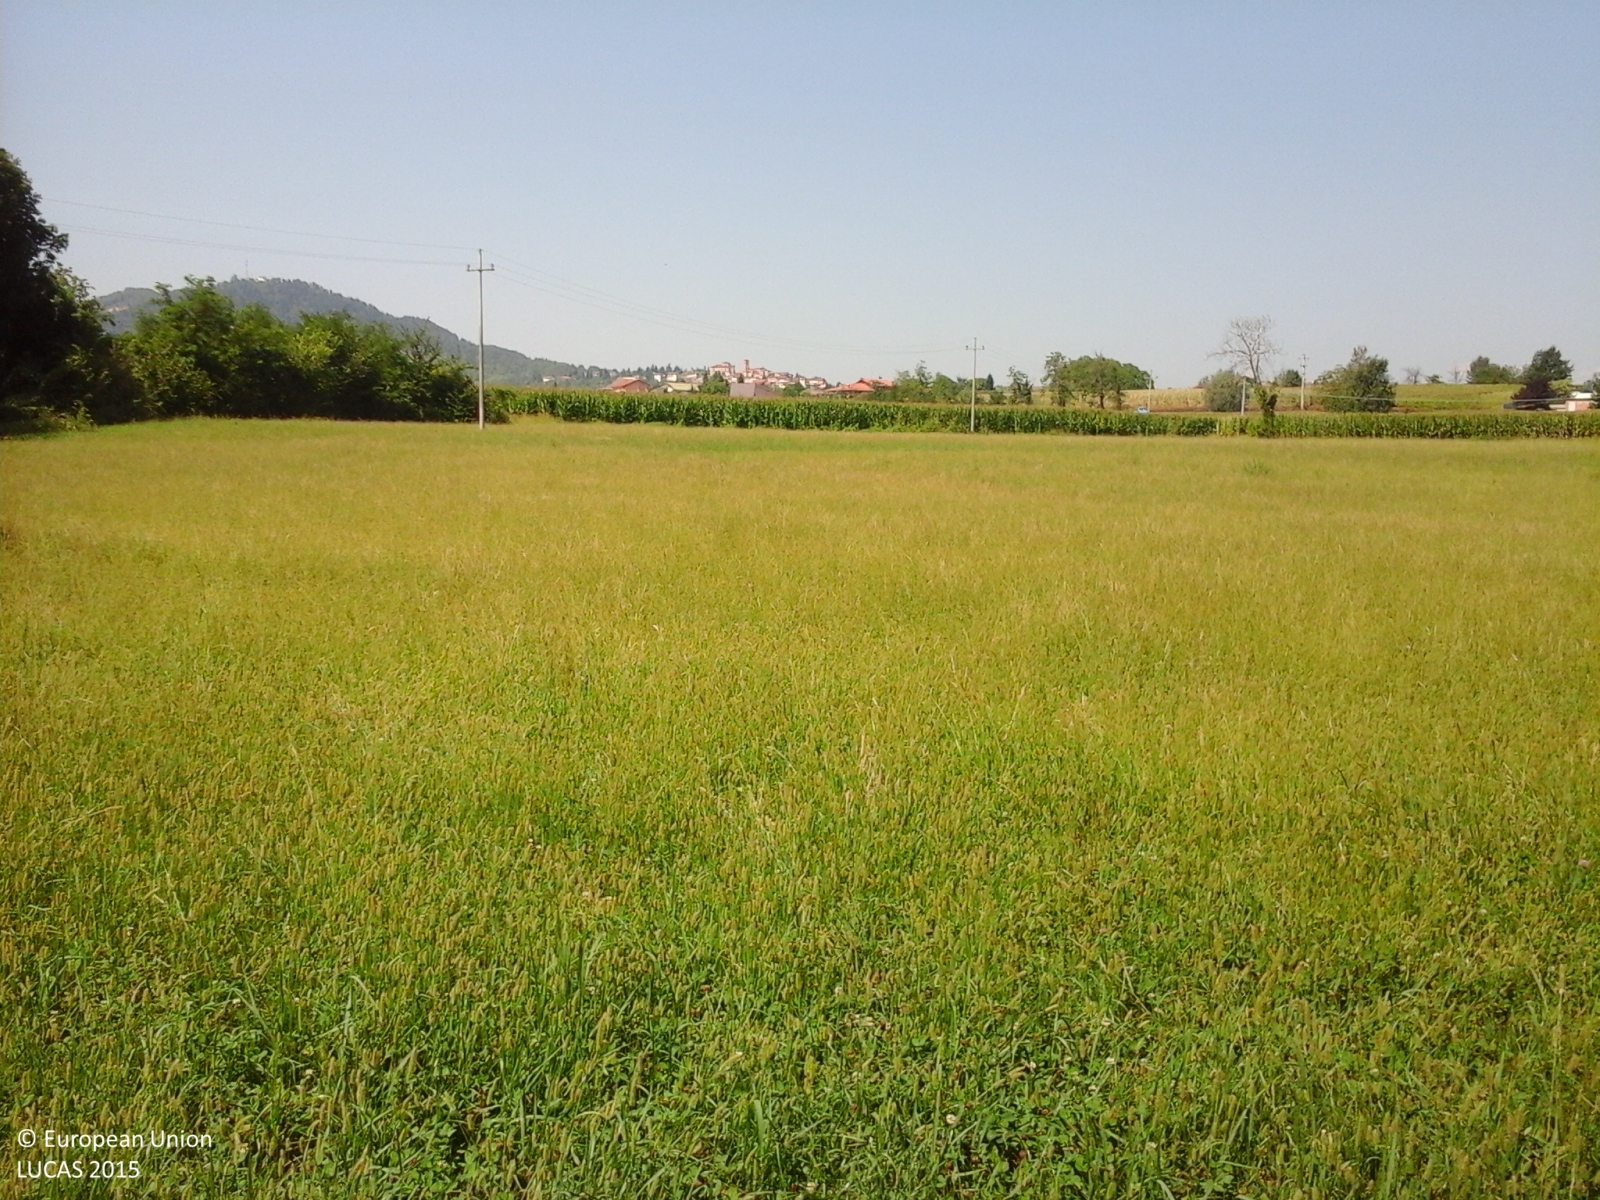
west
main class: Woodland
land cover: Broadleaved woodland
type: thermophilous deciduous forest
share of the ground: > 75 %
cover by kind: broadleaved forest trees 80 %, shrubs 20 %
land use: Semi-natural and natural areas not in use
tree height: > 5 m
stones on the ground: < 10 %
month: August
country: IT
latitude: 44.3450
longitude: 7.7845
